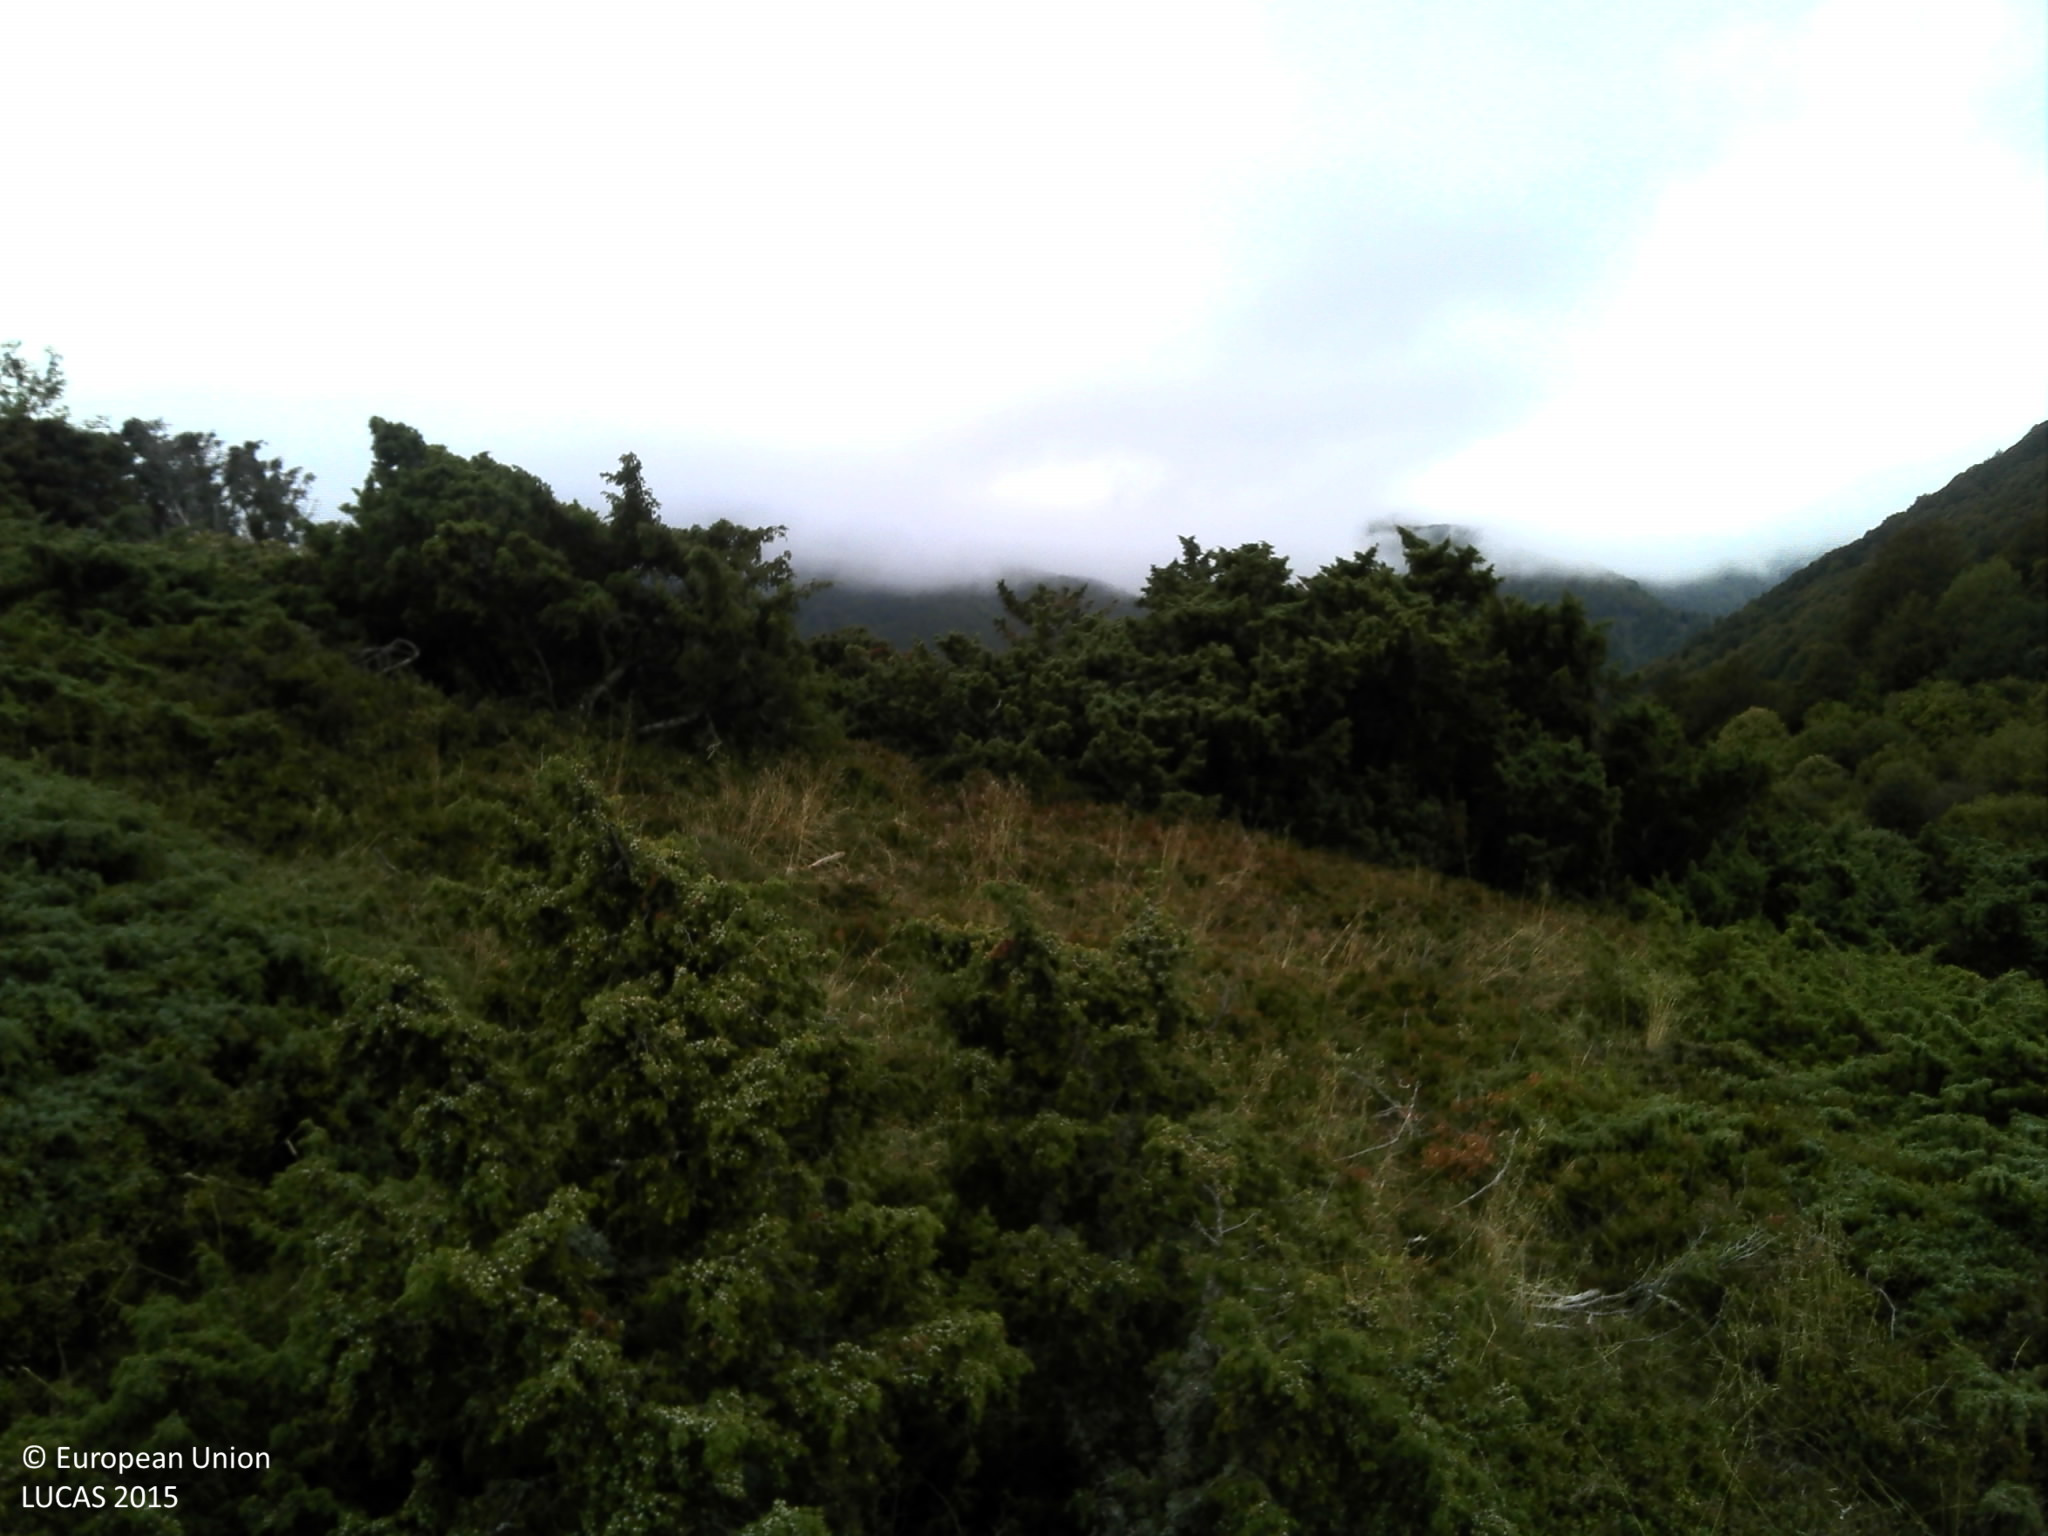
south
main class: Shrubland
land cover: Shrubland without tree cover
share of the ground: > 75 %
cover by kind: shrubs 90 %, herbaceous plants 10 %
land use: Agriculture (excluding fallow land and kitchen gardens)
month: September
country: FR
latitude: 45.5522
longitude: 2.8648
